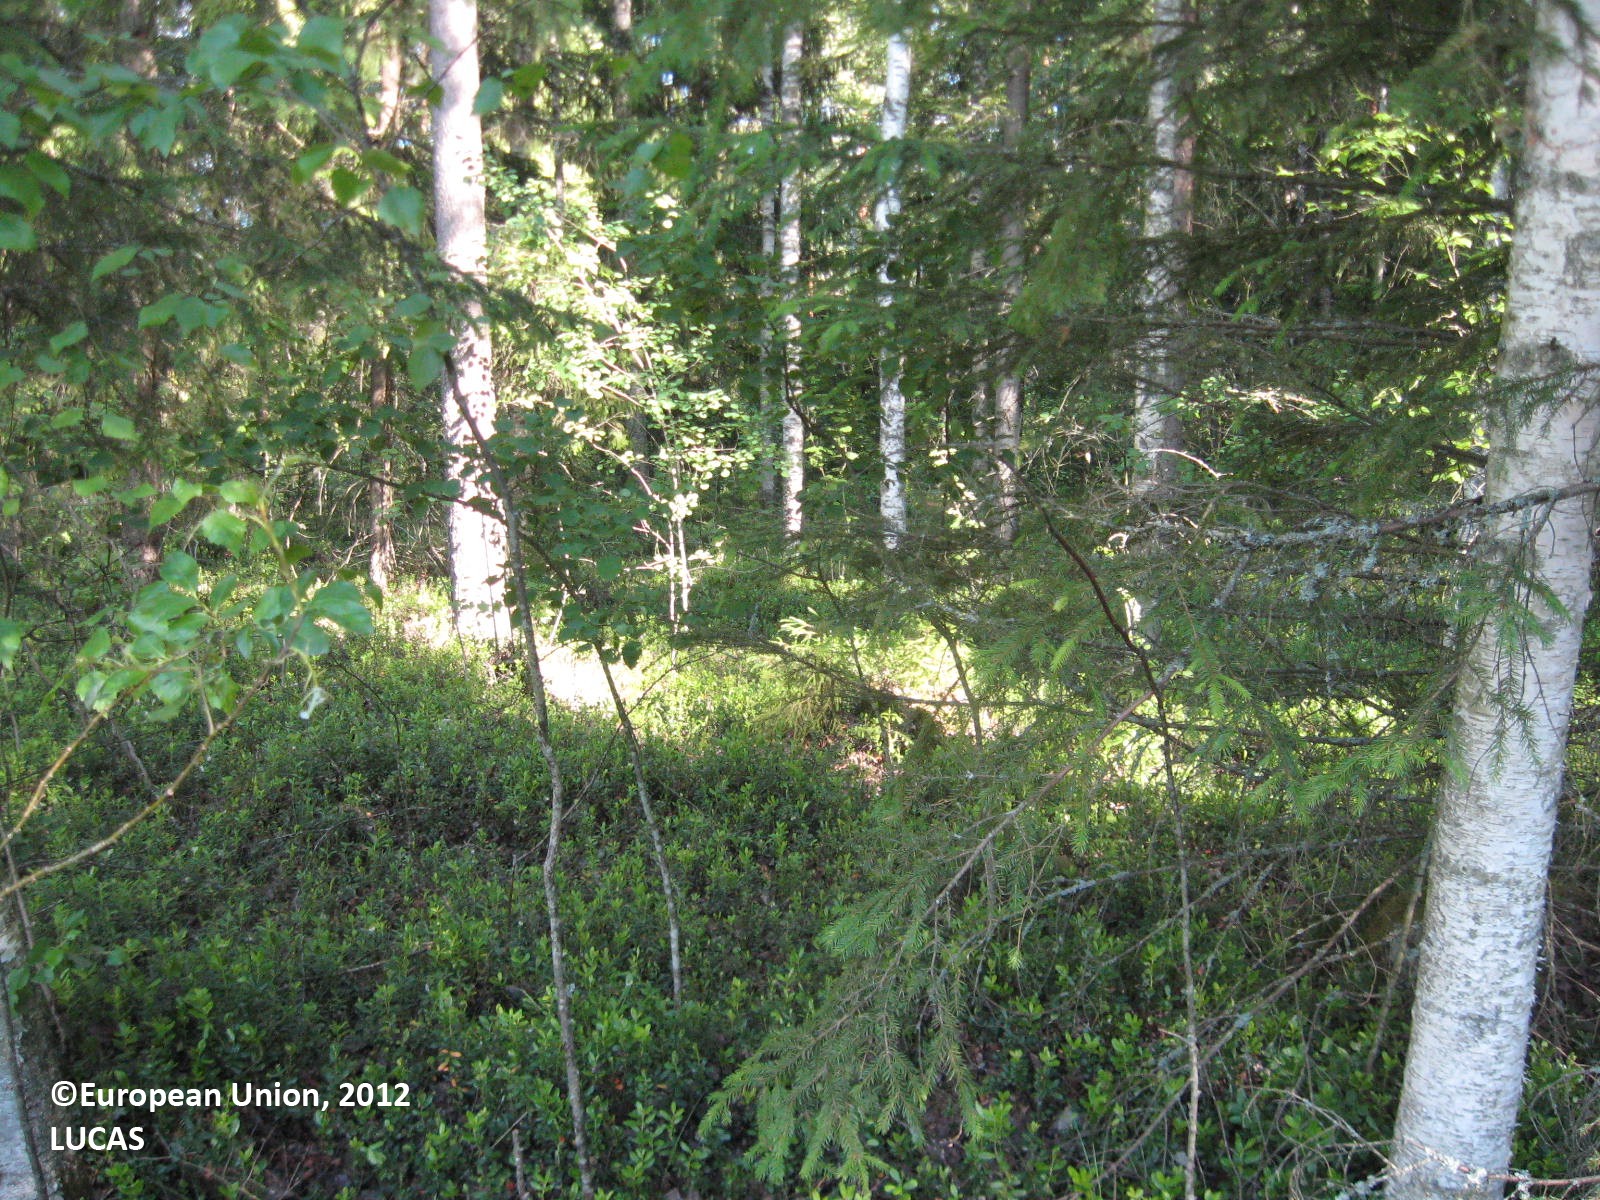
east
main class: Woodland
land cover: Pine dominated mixed woodland
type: boreal forest
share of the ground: > 75 %
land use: Forestry
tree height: > 5 m
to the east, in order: Pine dominated mixed woodland; Other mixed woodland; Ditches and canals; Pine dominated mixed woodland; Ditches and canals; Pine dominated coniferous woodland; Ditches and canals; Pine dominated coniferous woodland; Pine dominated mixed woodland
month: July
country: FI
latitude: 62.5932
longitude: 22.8144
